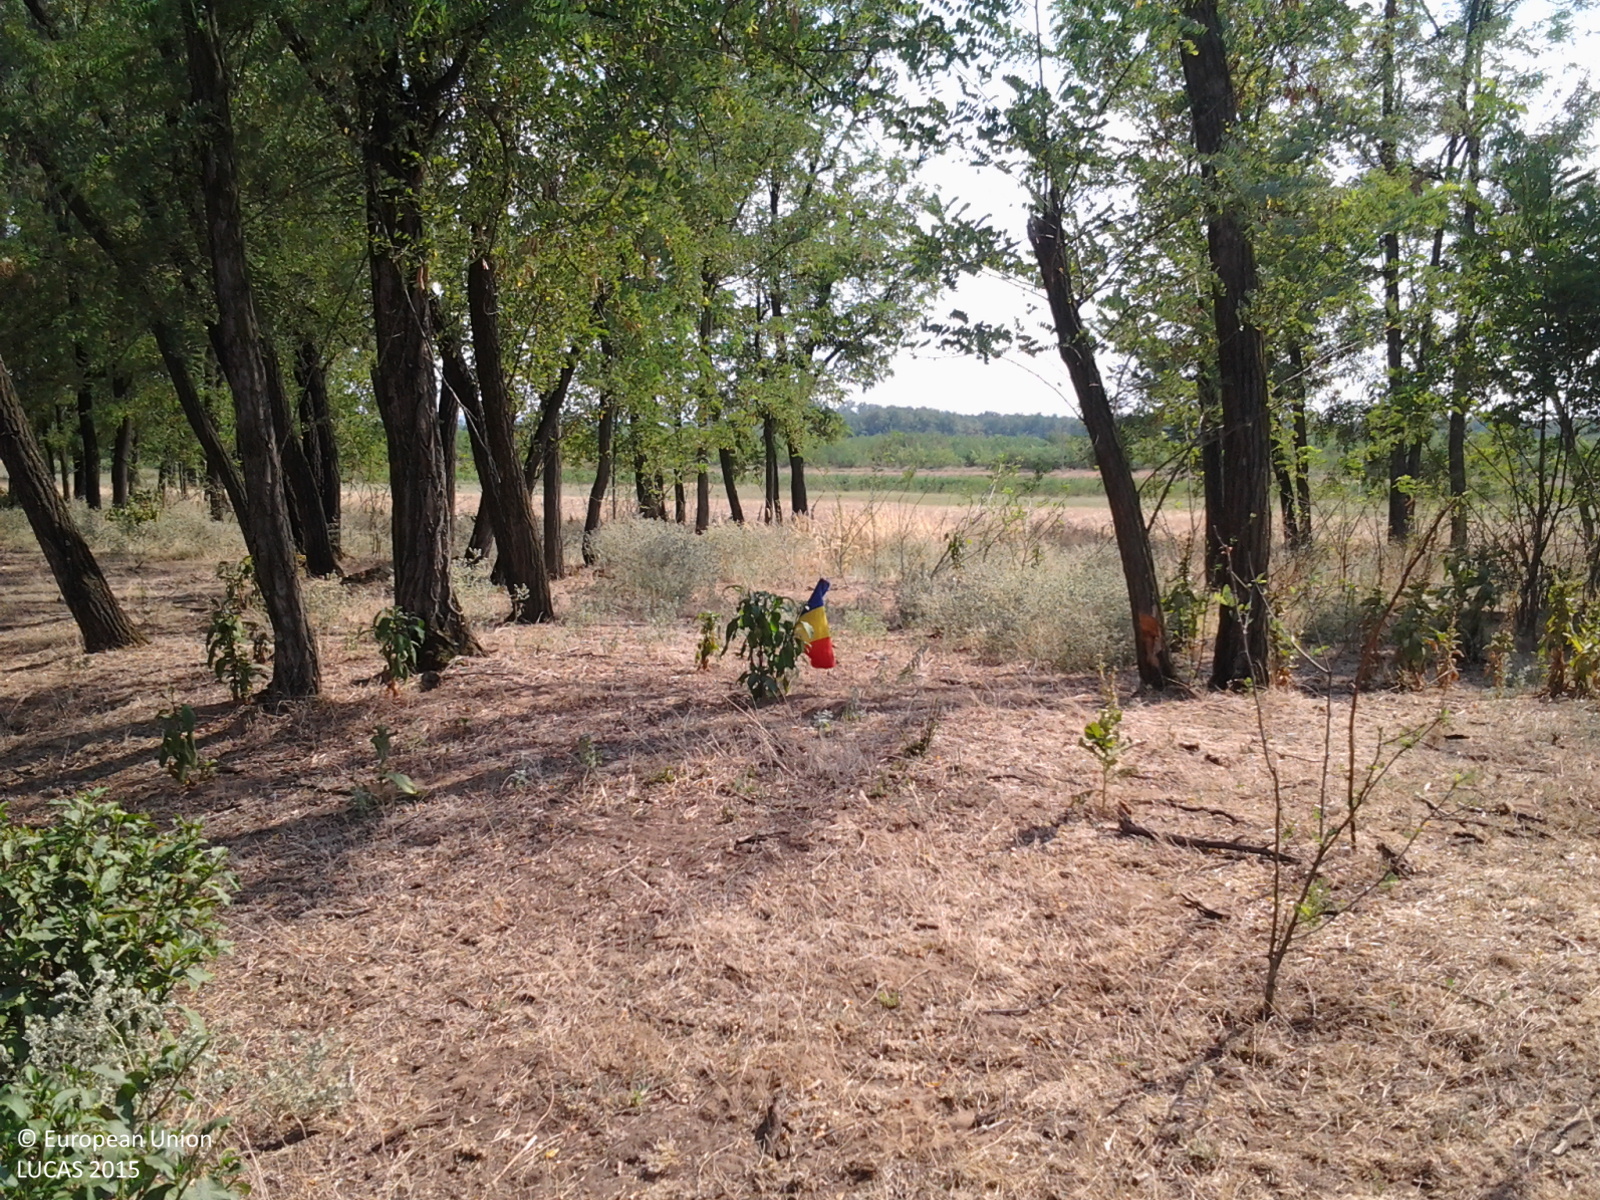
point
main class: Woodland
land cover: Broadleaved woodland
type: exotic forest
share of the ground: > 75 %
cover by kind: broadleaved forest trees 100 %
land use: Forestry
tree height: > 5 m
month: August
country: RO
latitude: 43.8668
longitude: 23.0692
